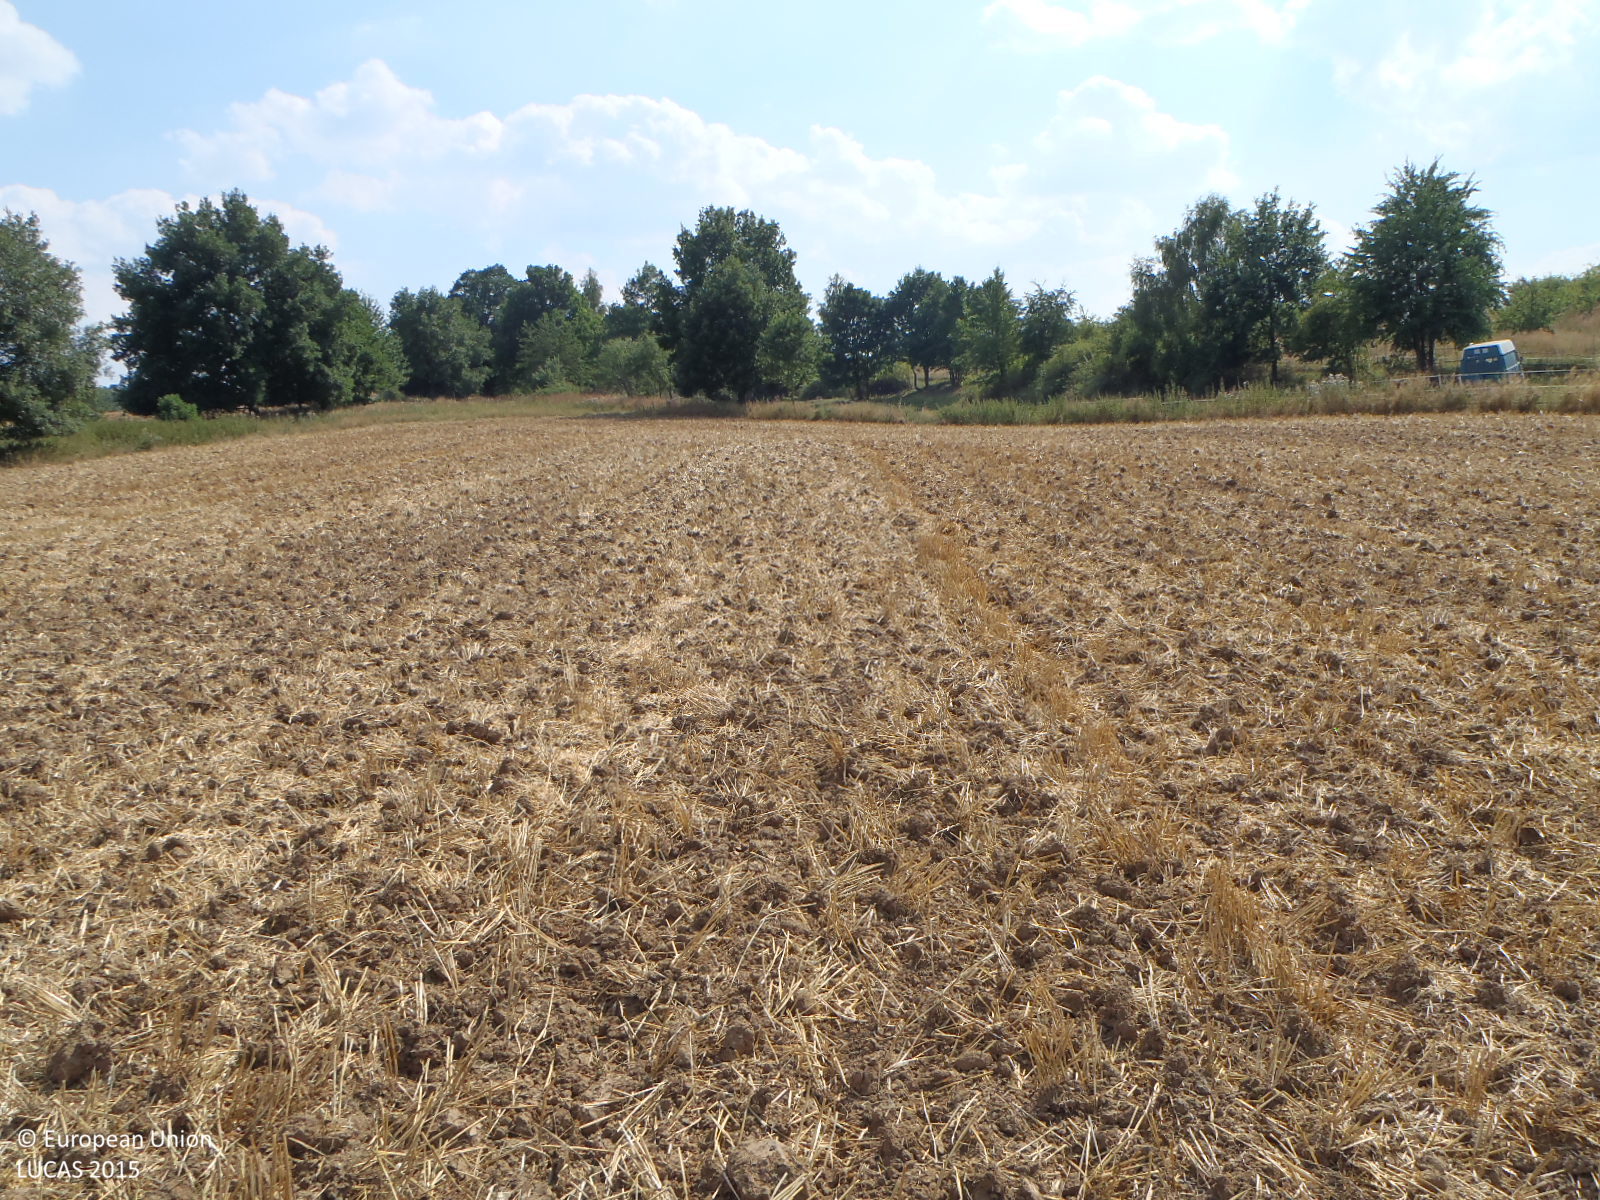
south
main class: Cropland
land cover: Common wheat
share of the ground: 25 - 50 %
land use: Agriculture (excluding fallow land and kitchen gardens)
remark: Harvested field
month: August
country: CZ
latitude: 50.5971
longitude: 14.5651
